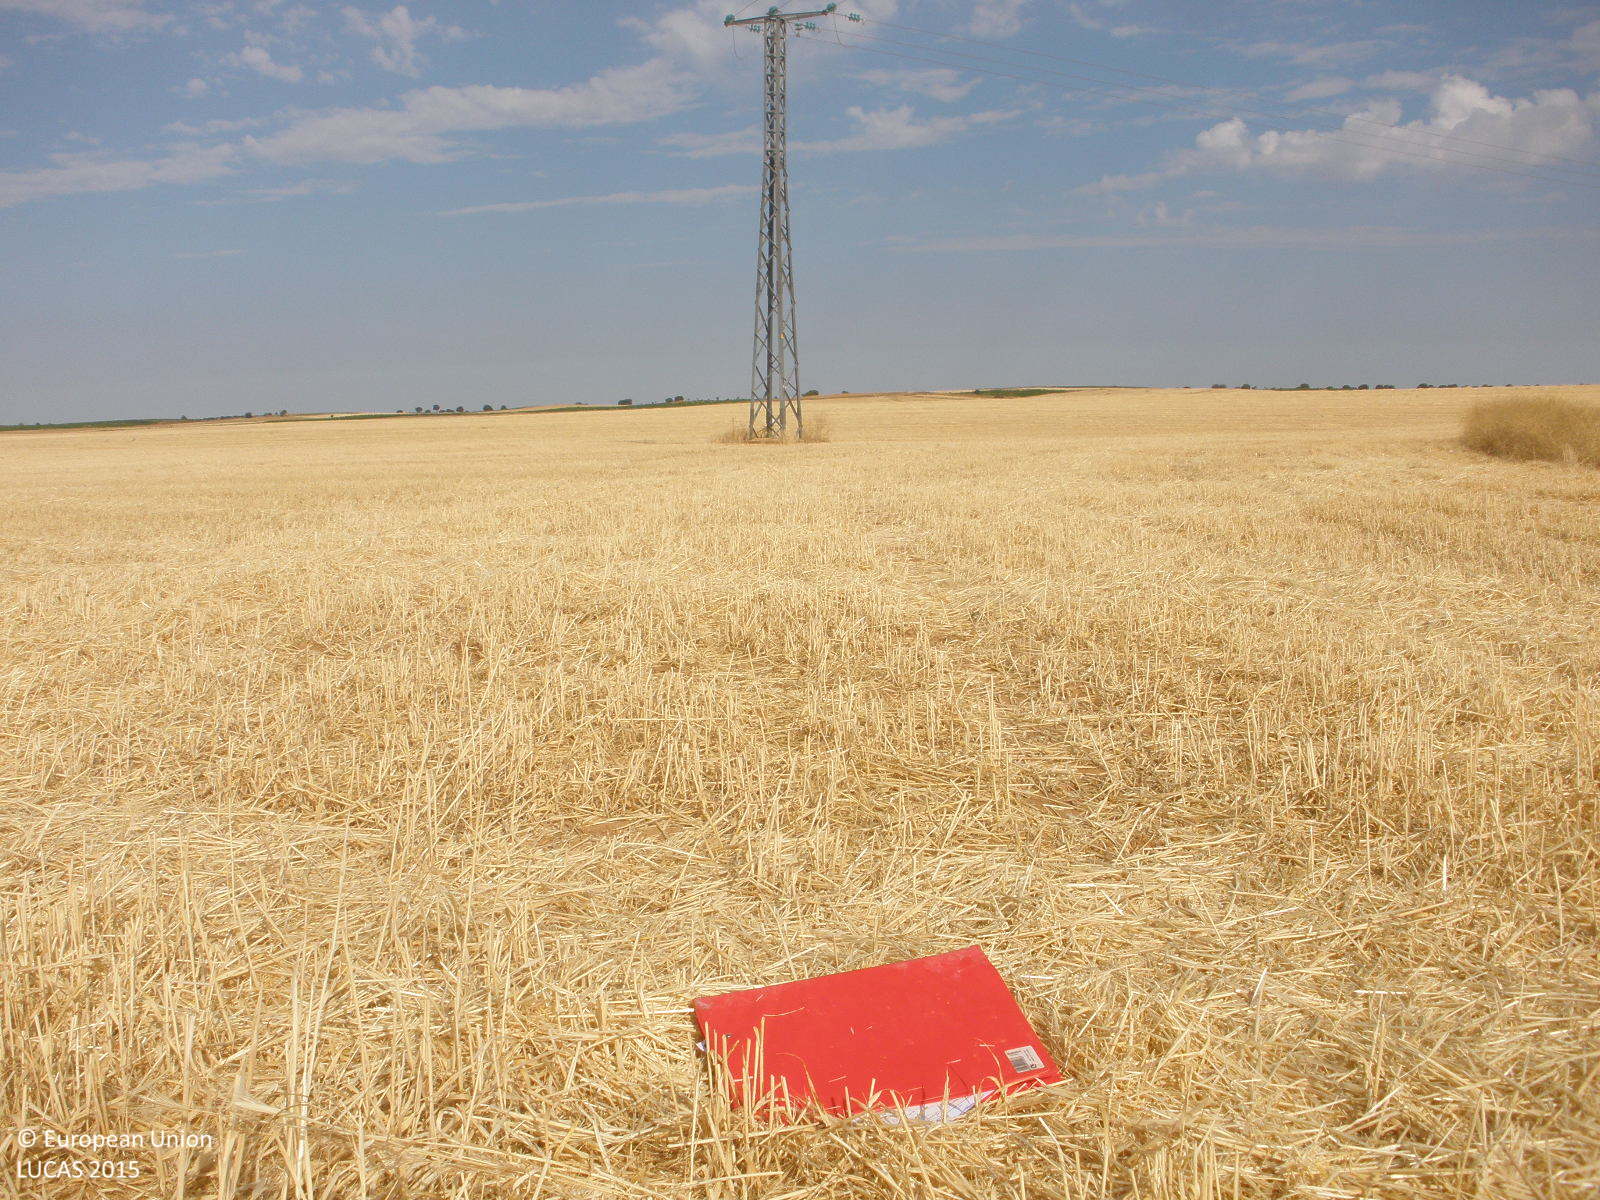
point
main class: Cropland
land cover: Barley
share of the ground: < 10 %
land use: Agriculture (excluding fallow land and kitchen gardens)
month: July
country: ES
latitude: 39.7912
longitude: -3.2074
